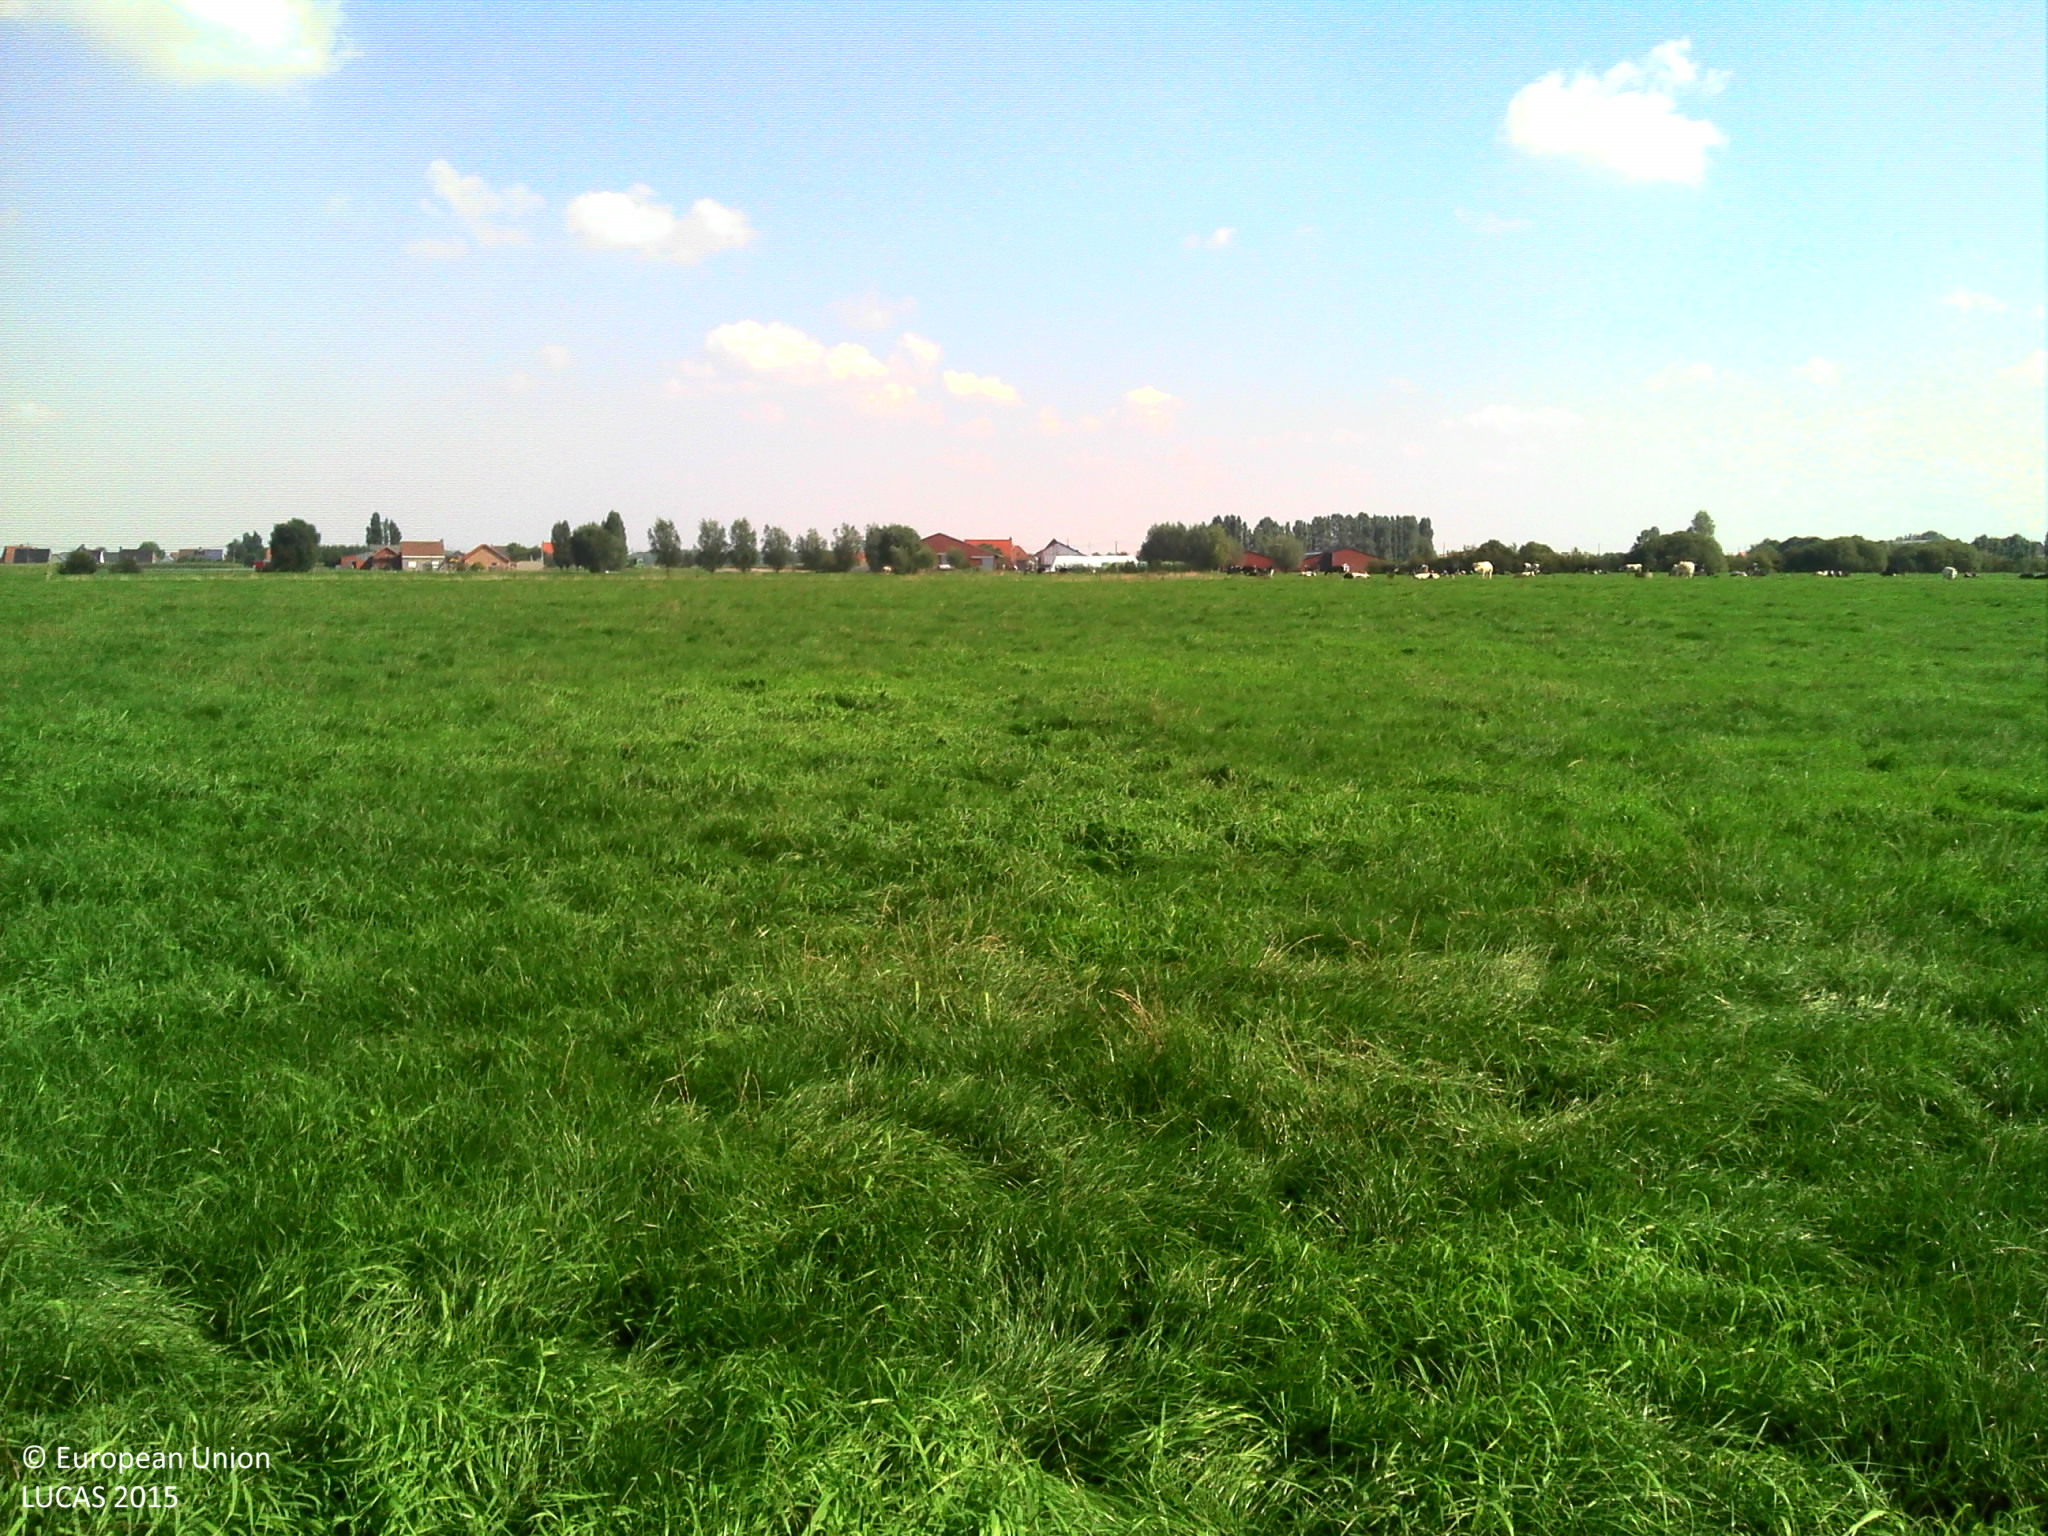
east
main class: Grassland
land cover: Grassland without tree/shrub cover
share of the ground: > 75 %
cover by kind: herbaceous plants 100 %
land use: Agriculture (excluding fallow land and kitchen gardens)
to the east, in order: Grassland without tree/shrub cover; Fences; Ditches and canals; Fences; Grassland without tree/shrub cover; Fences; Tracks; Fences; Ditches and canals; Fences; Grassland without tree/shrub cover
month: September
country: BE
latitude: 50.9494
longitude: 2.8006
